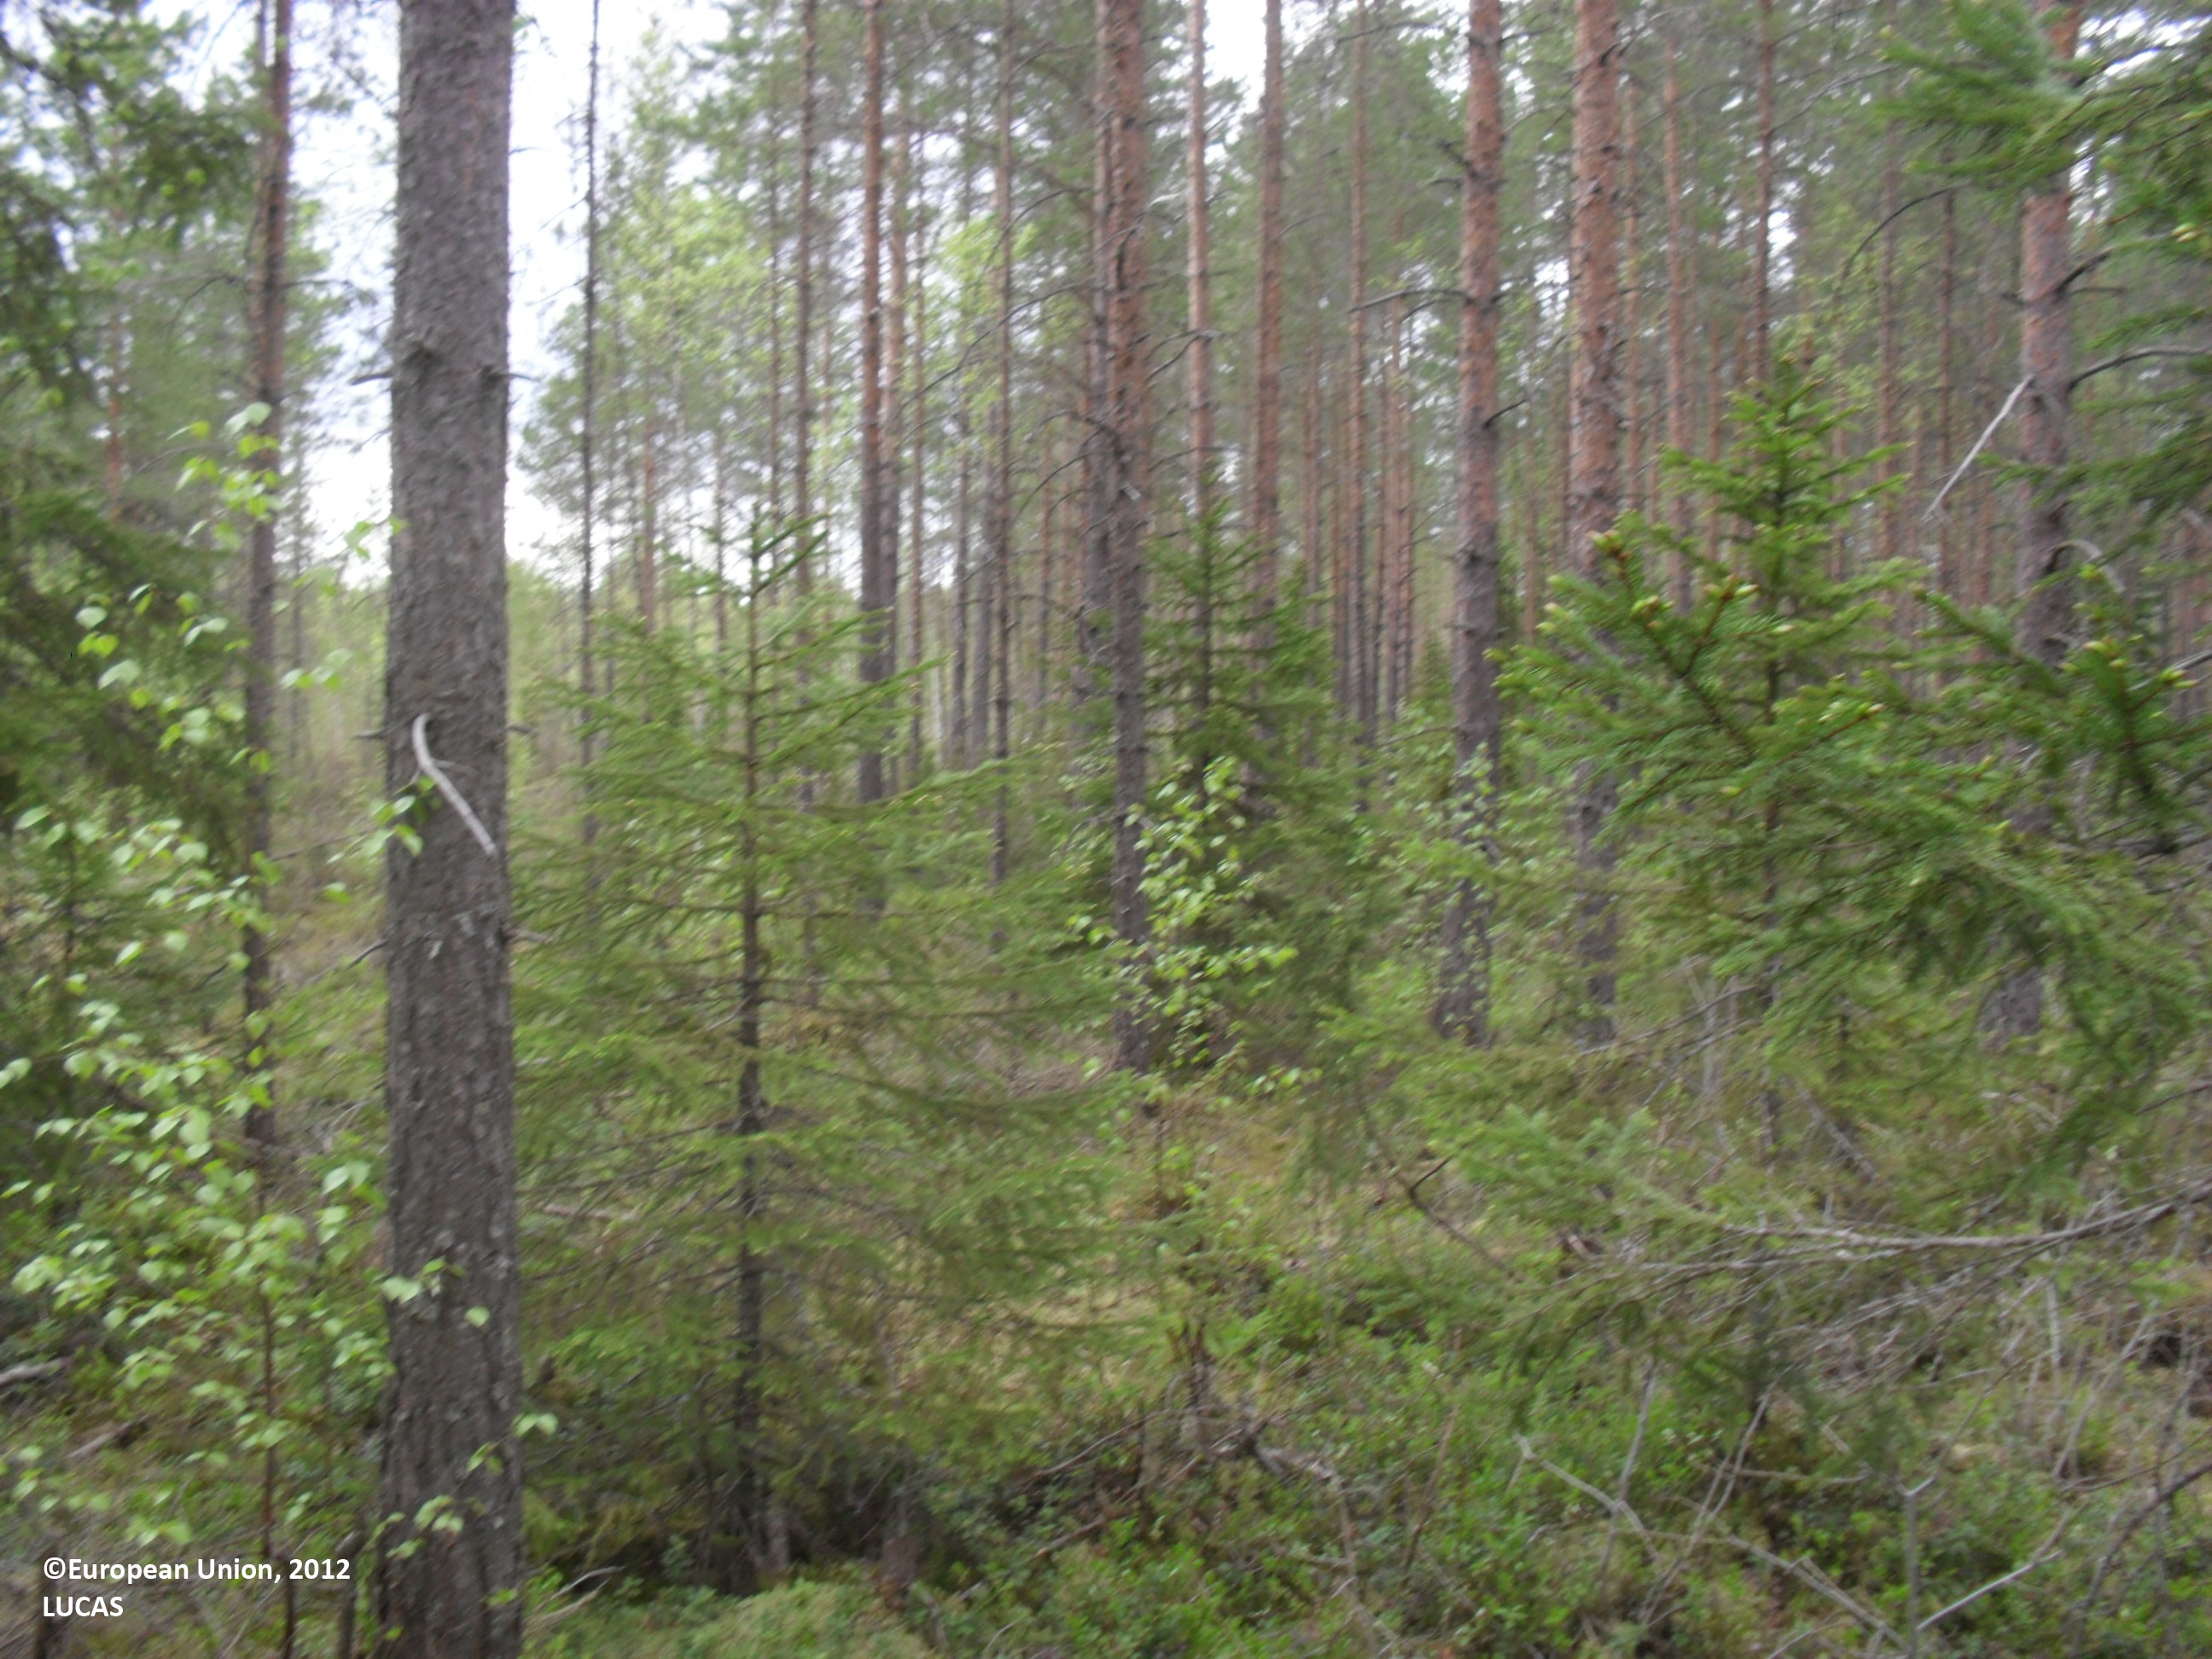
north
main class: Woodland
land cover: Pine dominated coniferous woodland
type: boreal forest
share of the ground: 50 - 75 %
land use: Forestry
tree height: > 5 m
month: May
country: FI
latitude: 63.2645
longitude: 23.1082
